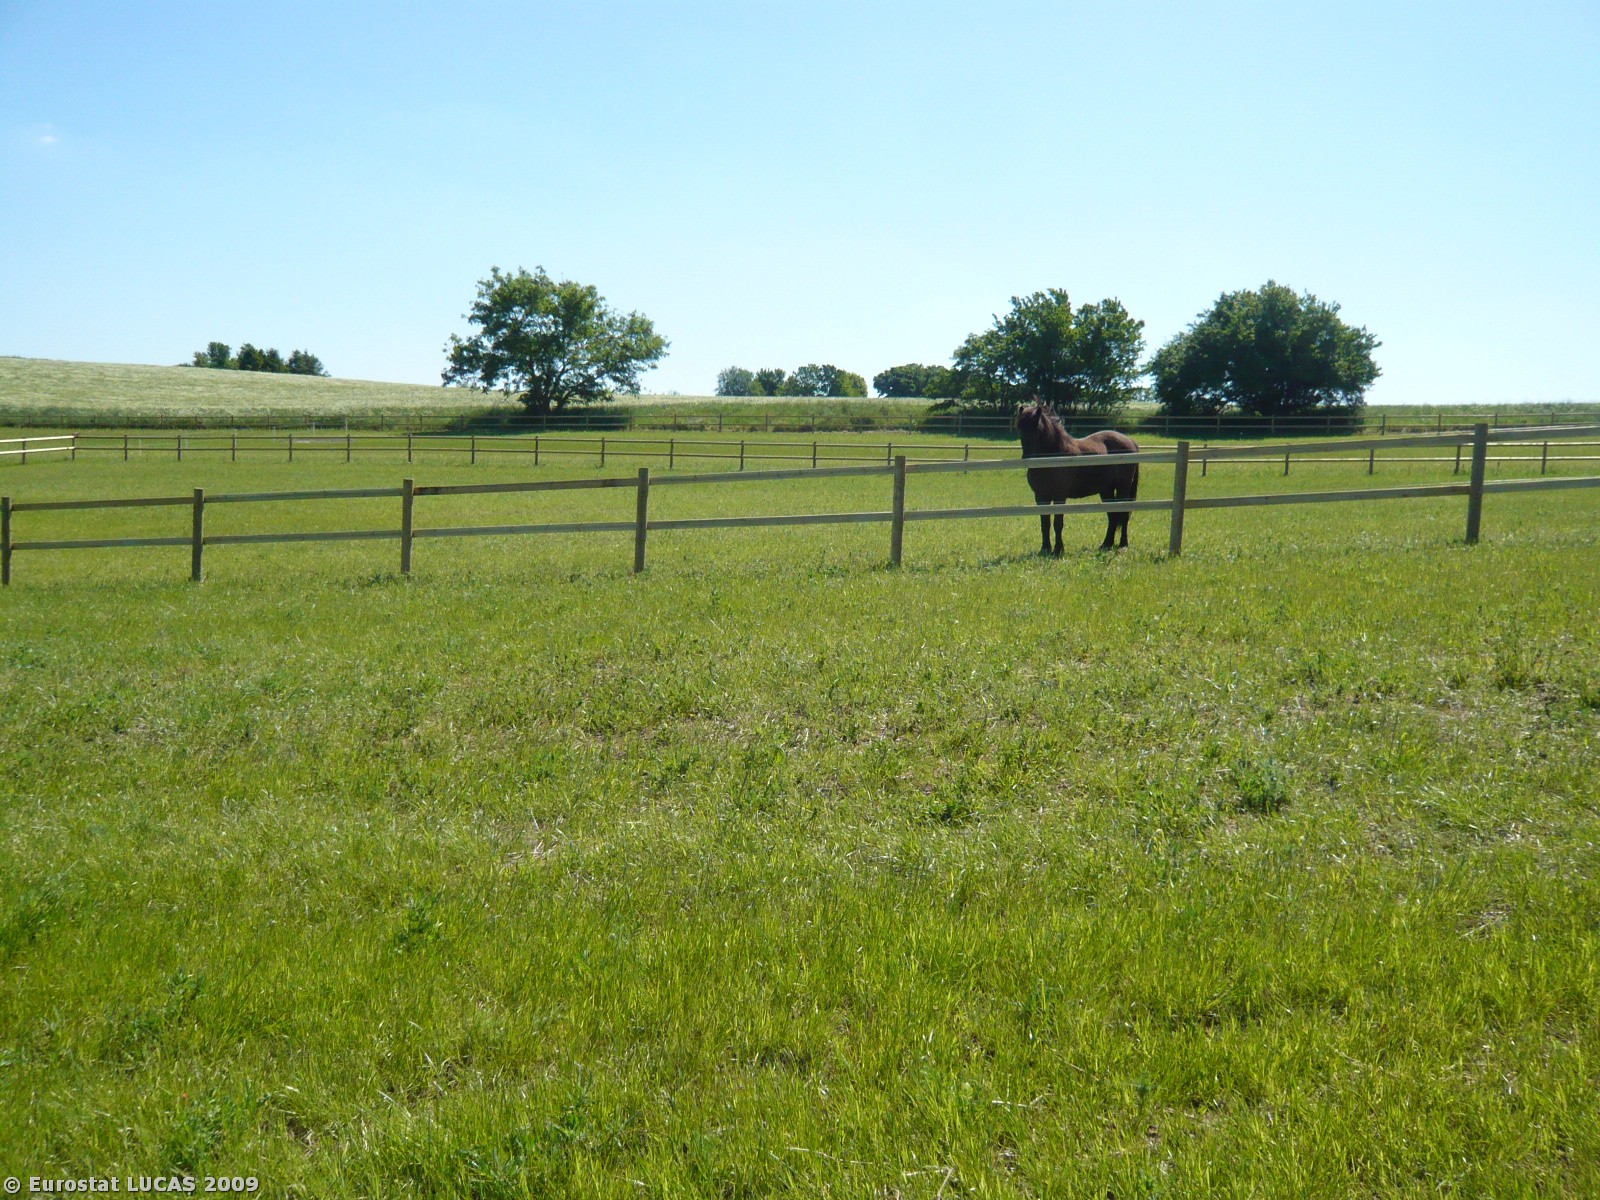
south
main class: Grassland
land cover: Grassland without tree/shrub cover
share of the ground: > 75 %
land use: Agriculture (excluding fallow land and kitchen gardens)
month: June
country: DK
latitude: 55.6505
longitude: 12.0165
